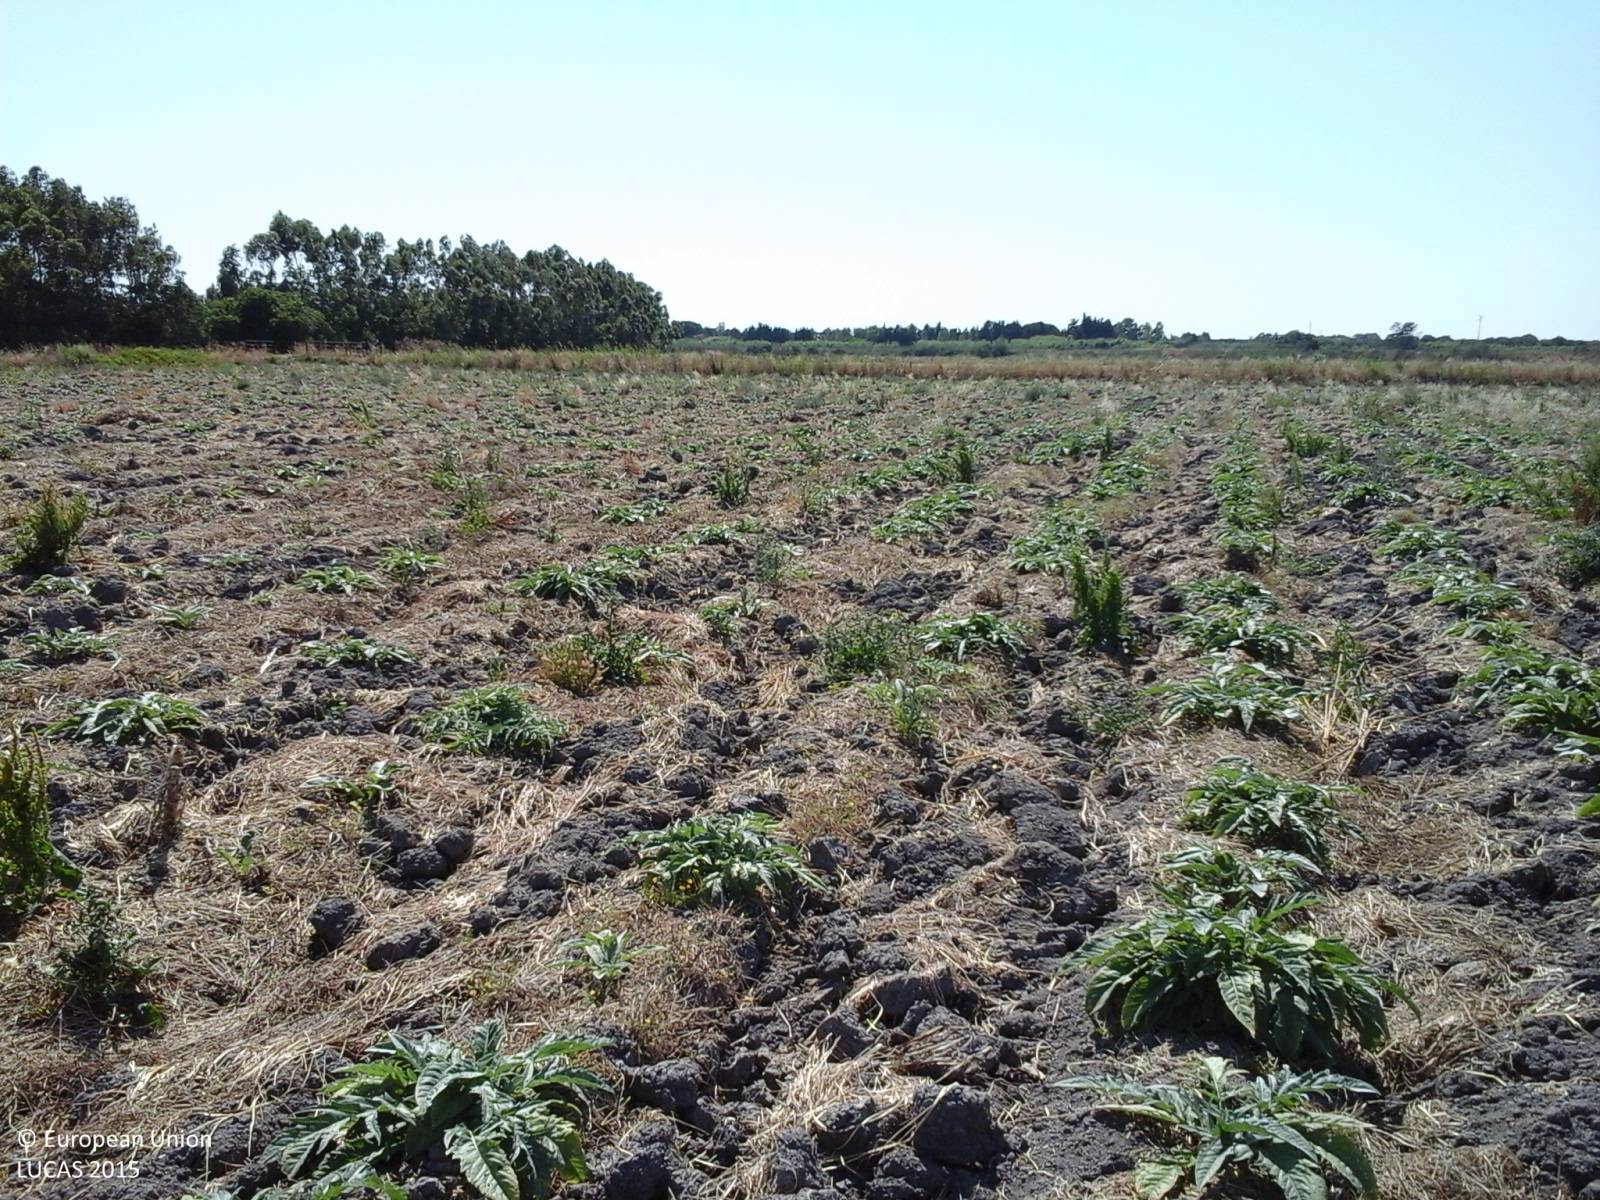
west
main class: Cropland
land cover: Other fresh vegetables
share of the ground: 50 - 75 %
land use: Agriculture (excluding fallow land and kitchen gardens)
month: July
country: IT
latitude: 40.0030
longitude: 8.5437
